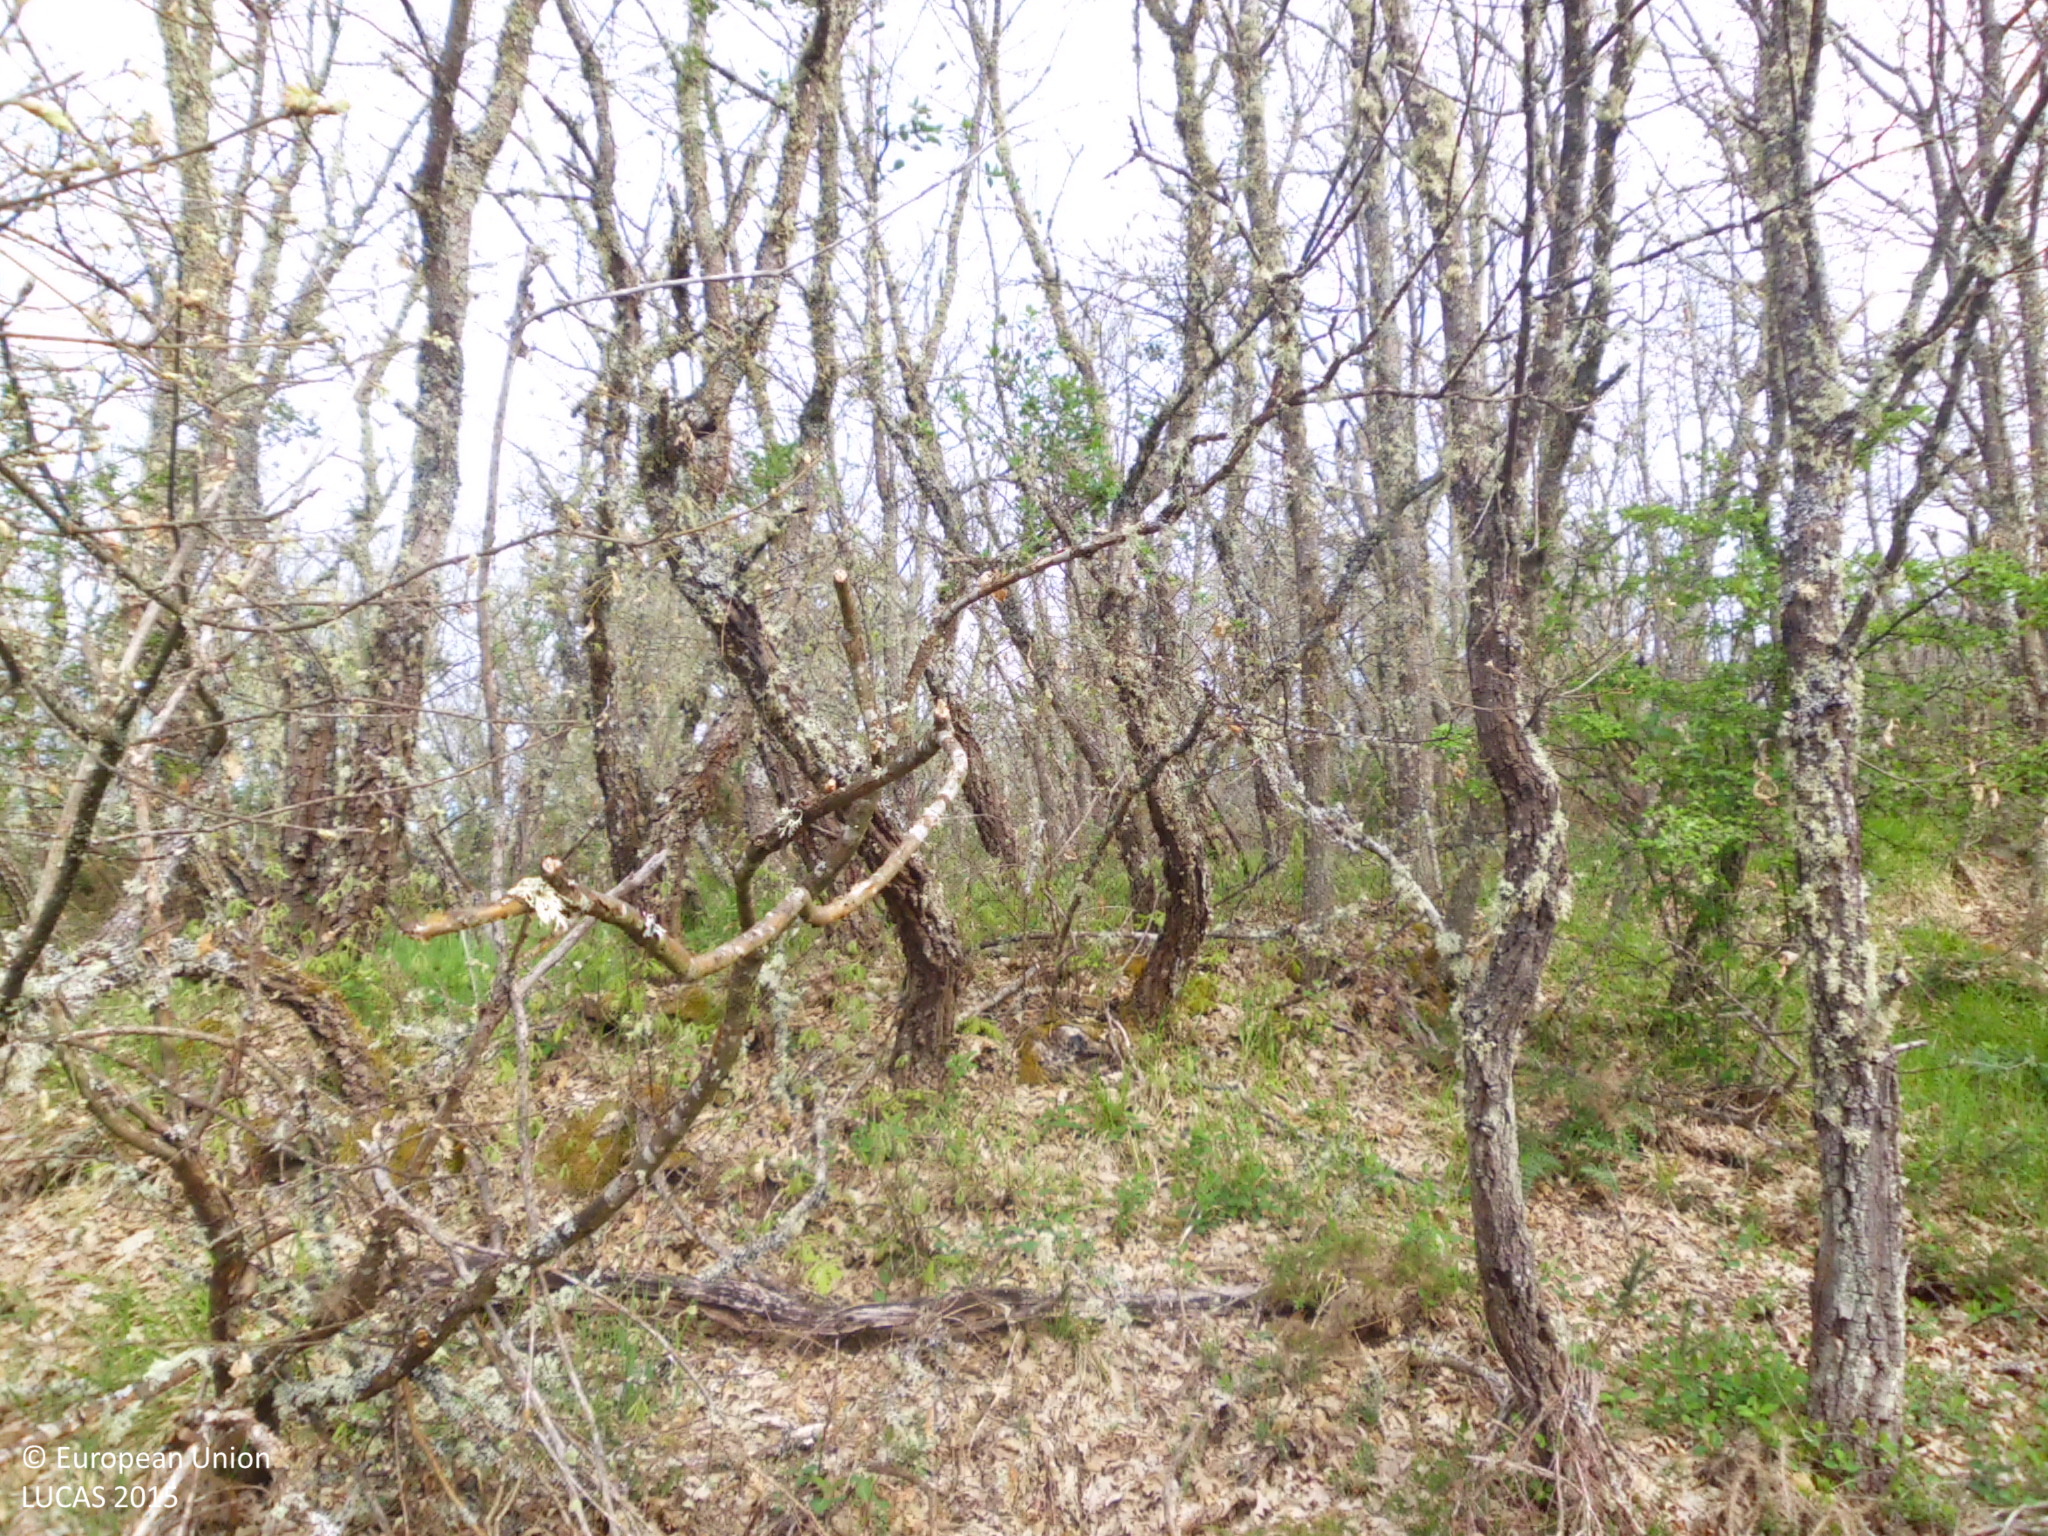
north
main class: Woodland
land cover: Broadleaved woodland
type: acidophilous oak and oak-birch forest
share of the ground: 50 - 75 %
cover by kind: broadleaved forest trees 70 %, herbaceous plants 20 %, shrubs 10 %
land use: Semi-natural and natural areas not in use
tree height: > 5 m
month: May
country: ES
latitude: 42.9194
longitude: -3.8760
